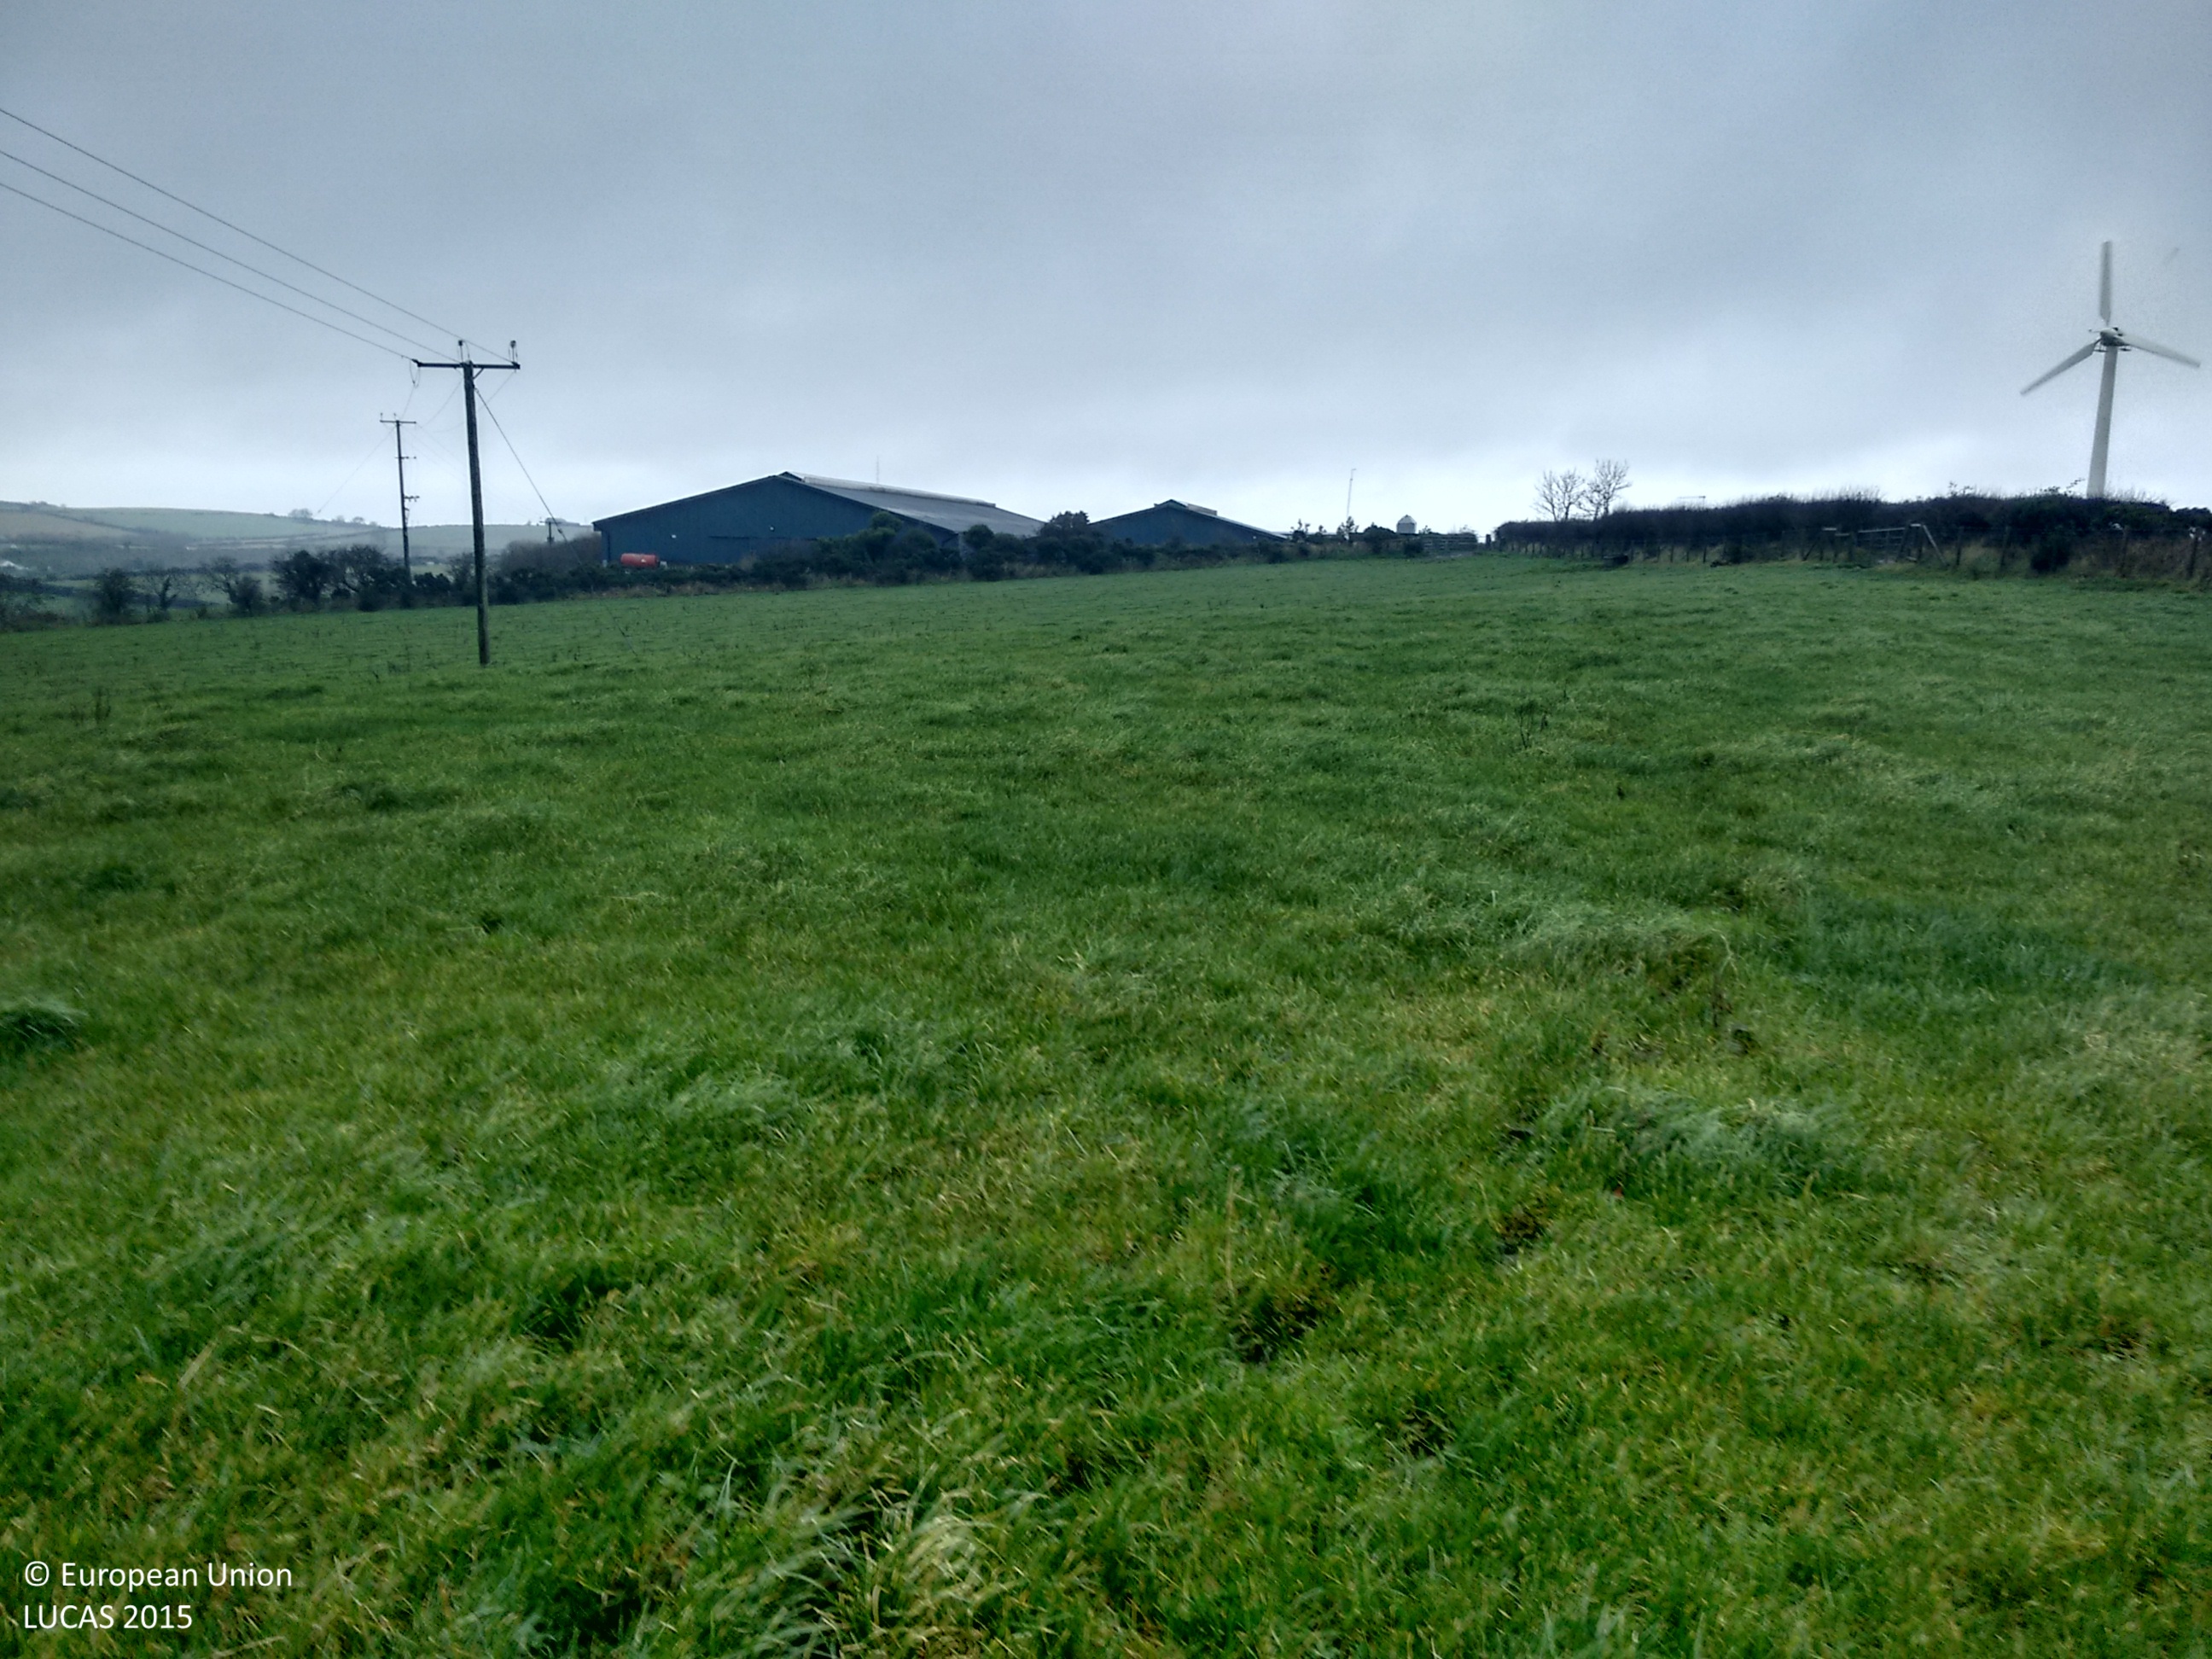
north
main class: Grassland
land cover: Grassland without tree/shrub cover
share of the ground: > 75 %
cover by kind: herbaceous plants 100 %
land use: Agriculture (excluding fallow land and kitchen gardens)
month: November
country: GB
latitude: 54.6134
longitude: -5.7894
